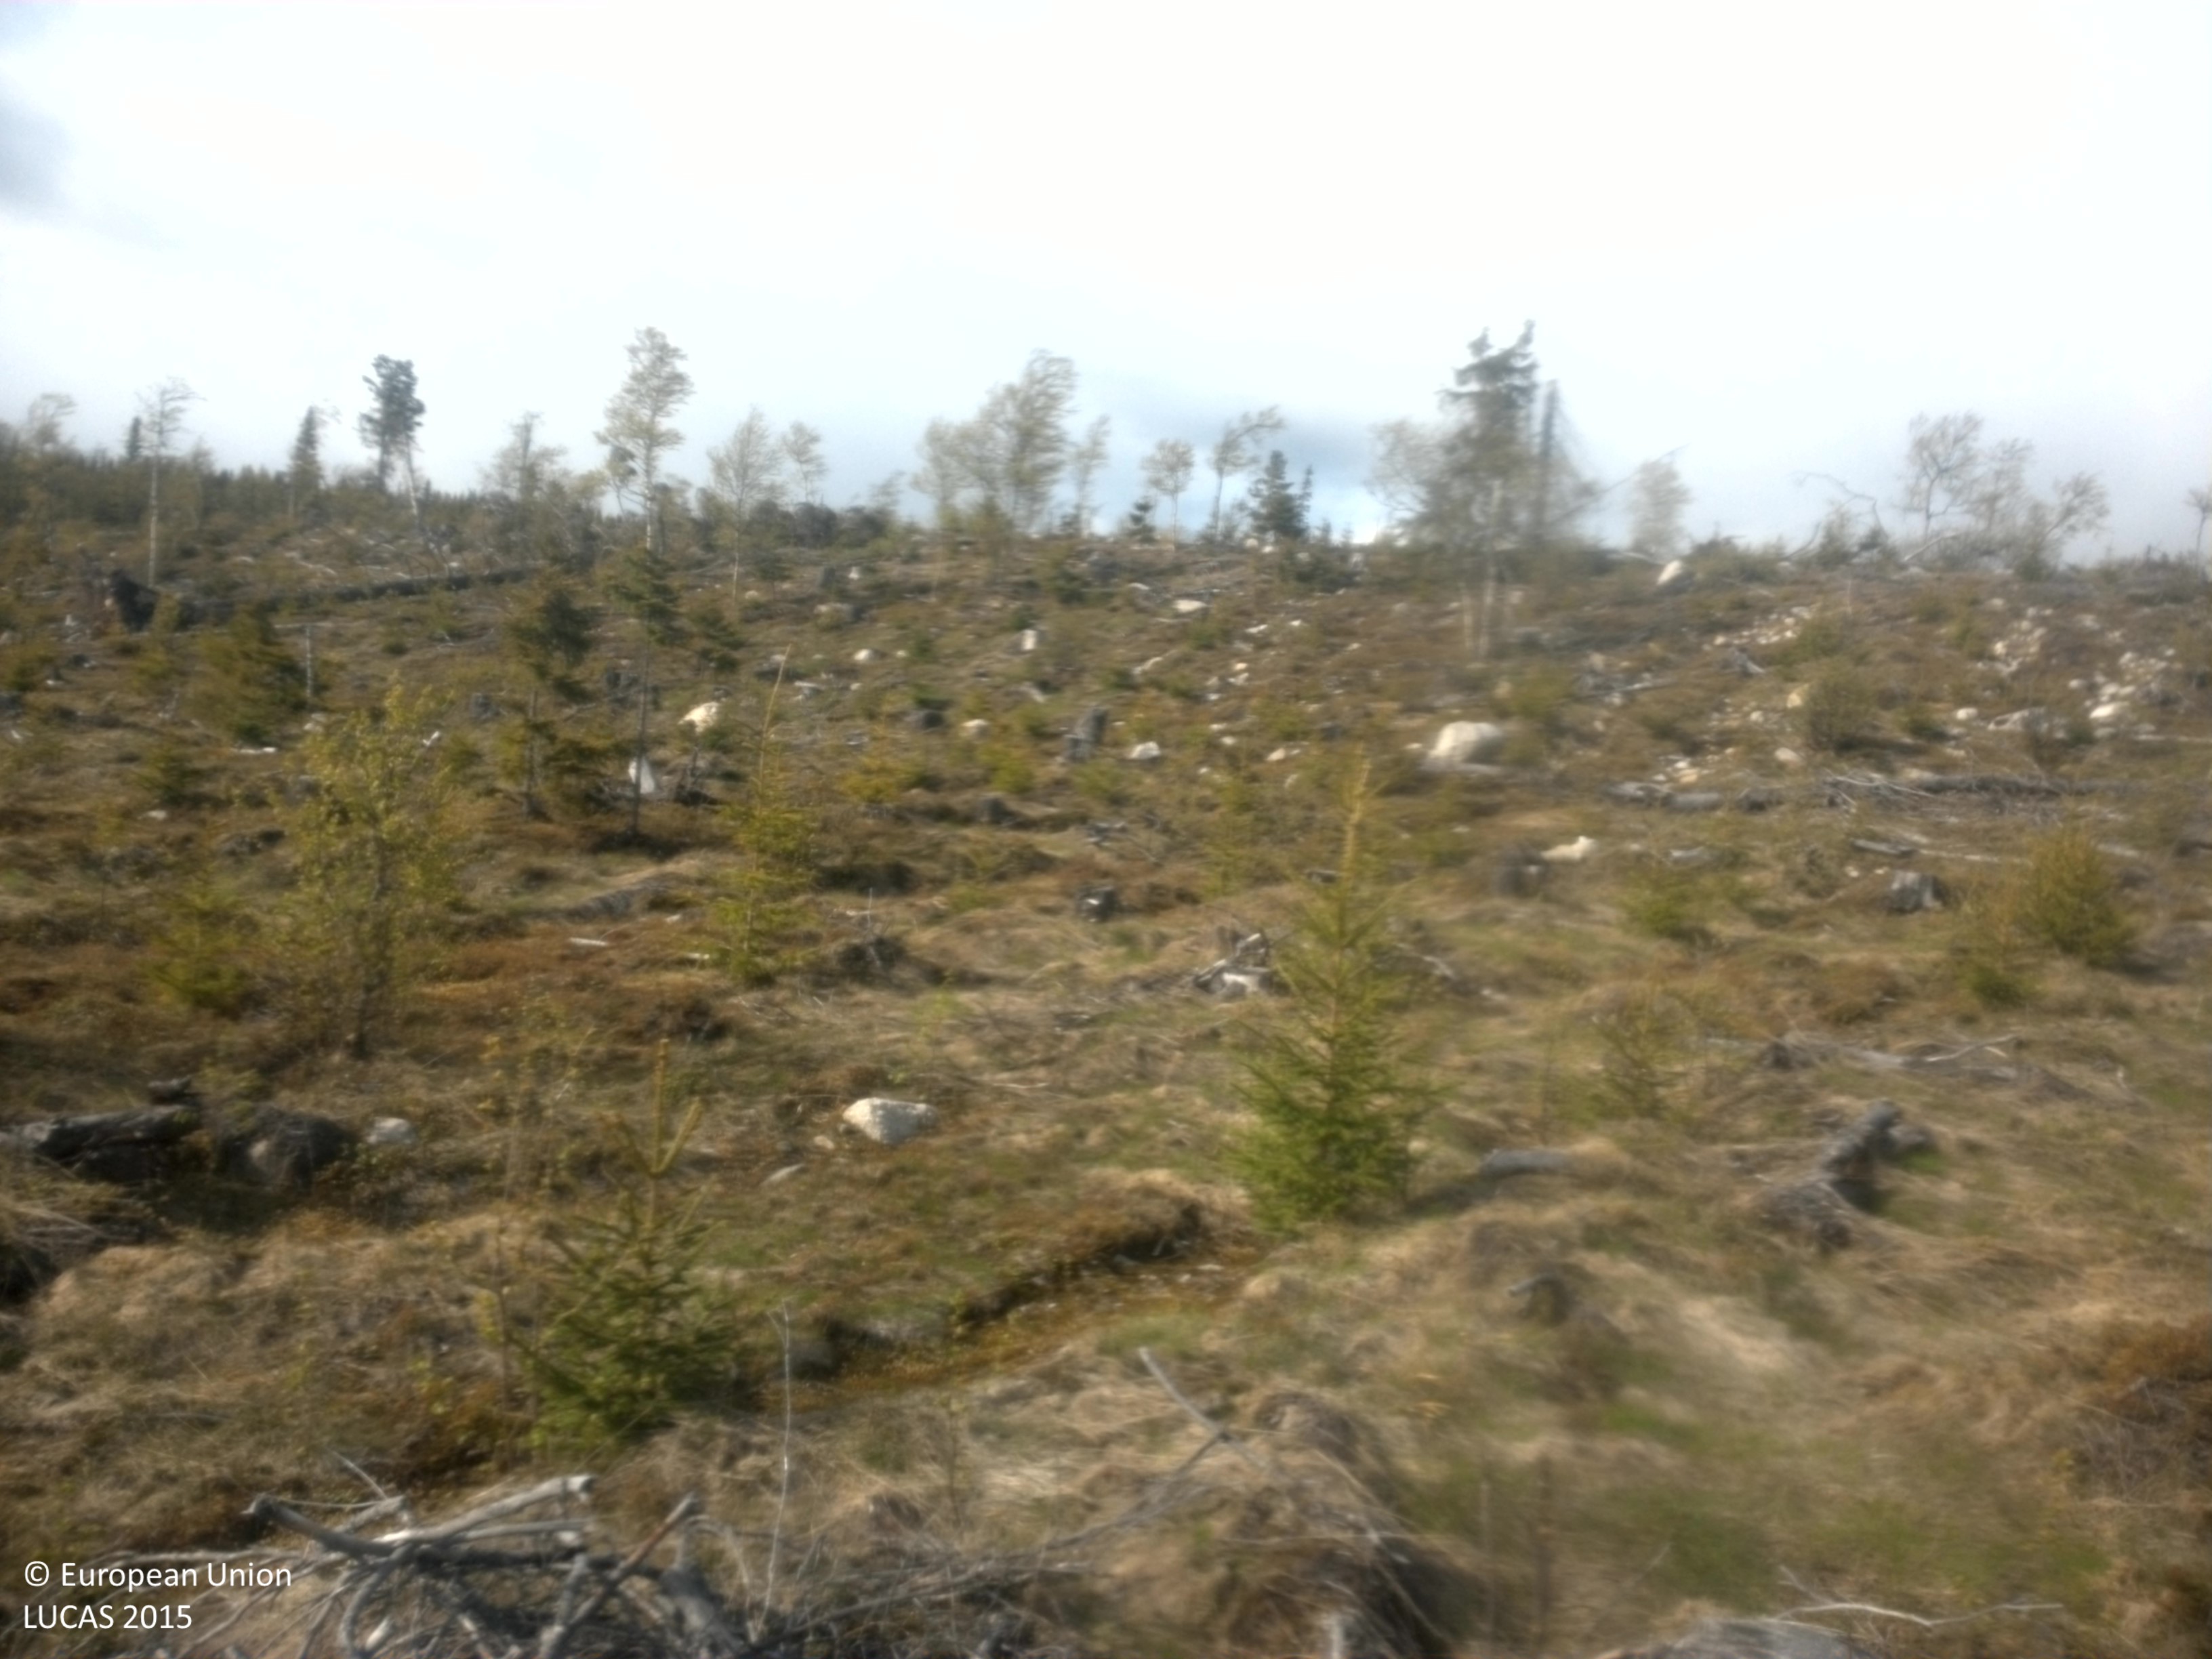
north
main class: Woodland
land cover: Spruce dominated mixed woodland
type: boreal forest
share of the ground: 10 - 25 %
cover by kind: herbaceous plants 55 %, coniferous forest trees 15 %, lichens and mosses 10 %, unconsolidated bare surface 10 %, broadleaved forest trees 5 %, shrubs 5 %
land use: Forestry
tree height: < 5 m
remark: Clear cut
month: June
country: SE
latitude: 64.4841
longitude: 17.6866
